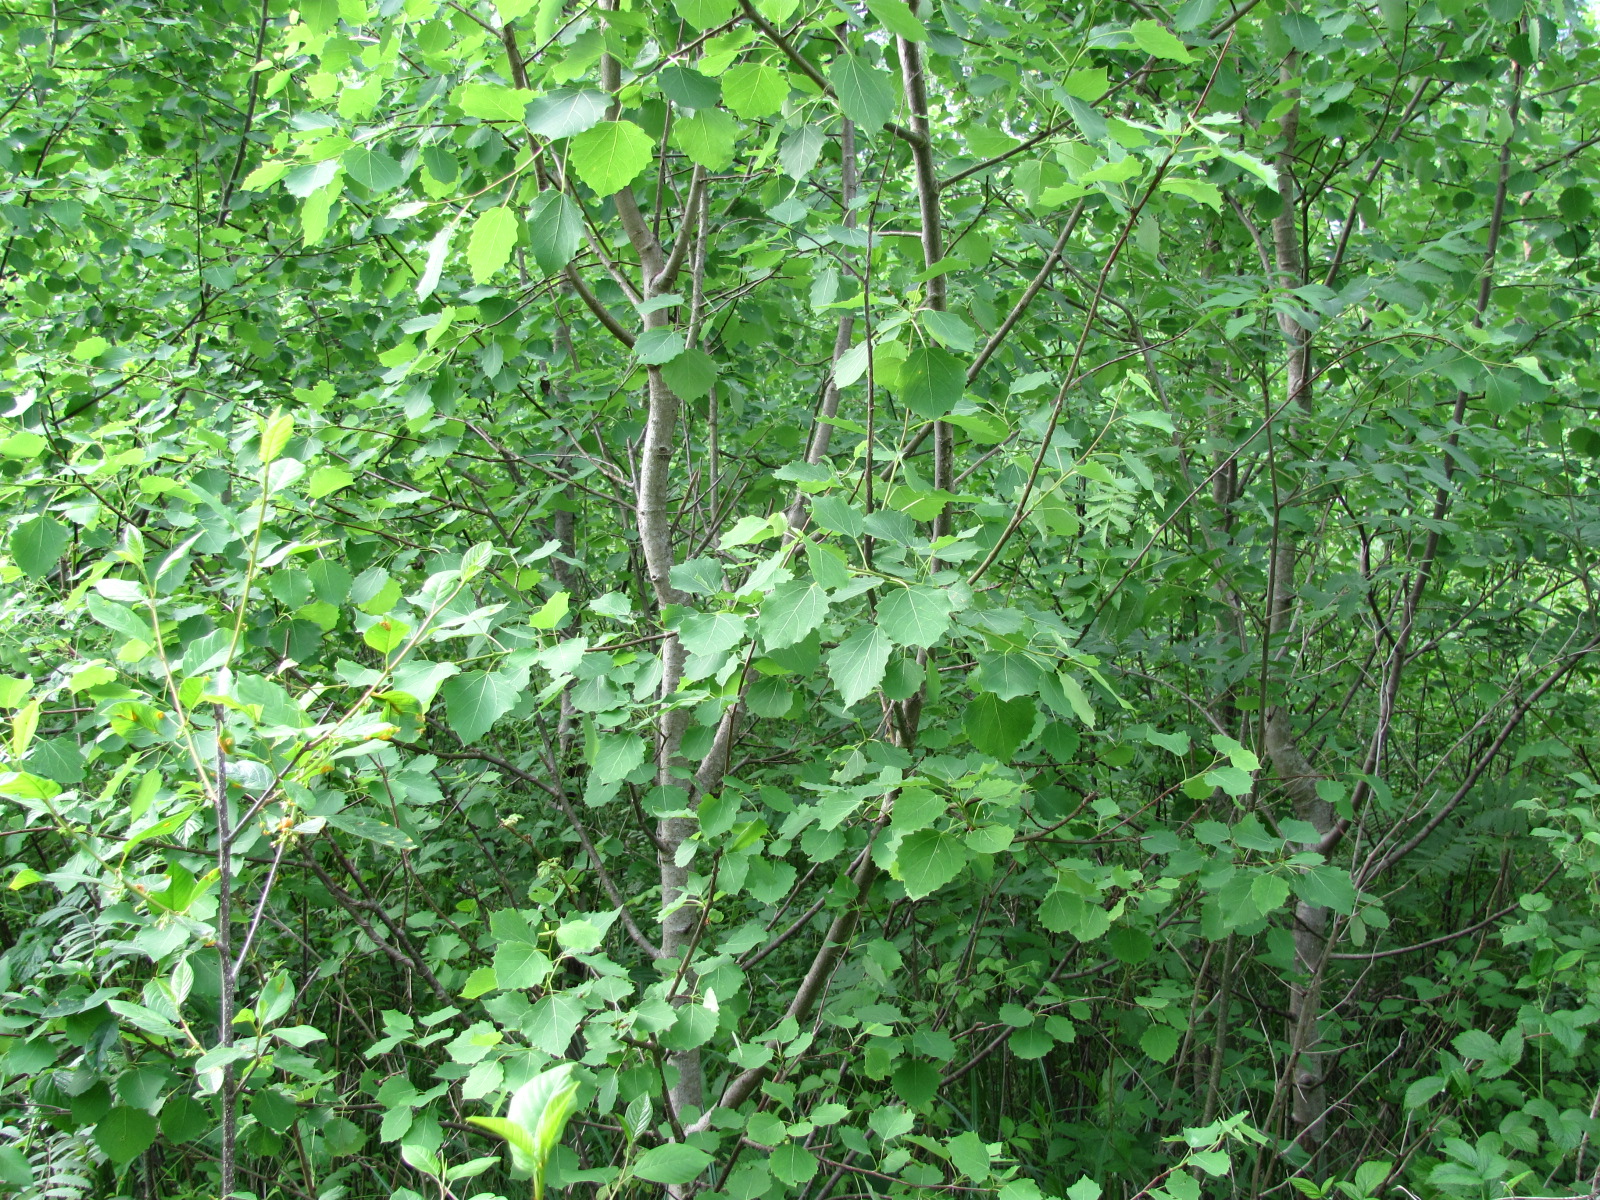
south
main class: Woodland
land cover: Broadleaved woodland
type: non-riverine alder, birch or aspen forest
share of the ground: 50 - 75 %
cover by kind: broadleaved forest trees 70 %, shrubs 30 %
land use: Forestry
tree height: < 5 m
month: June
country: LV
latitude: 56.7040
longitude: 23.9167
